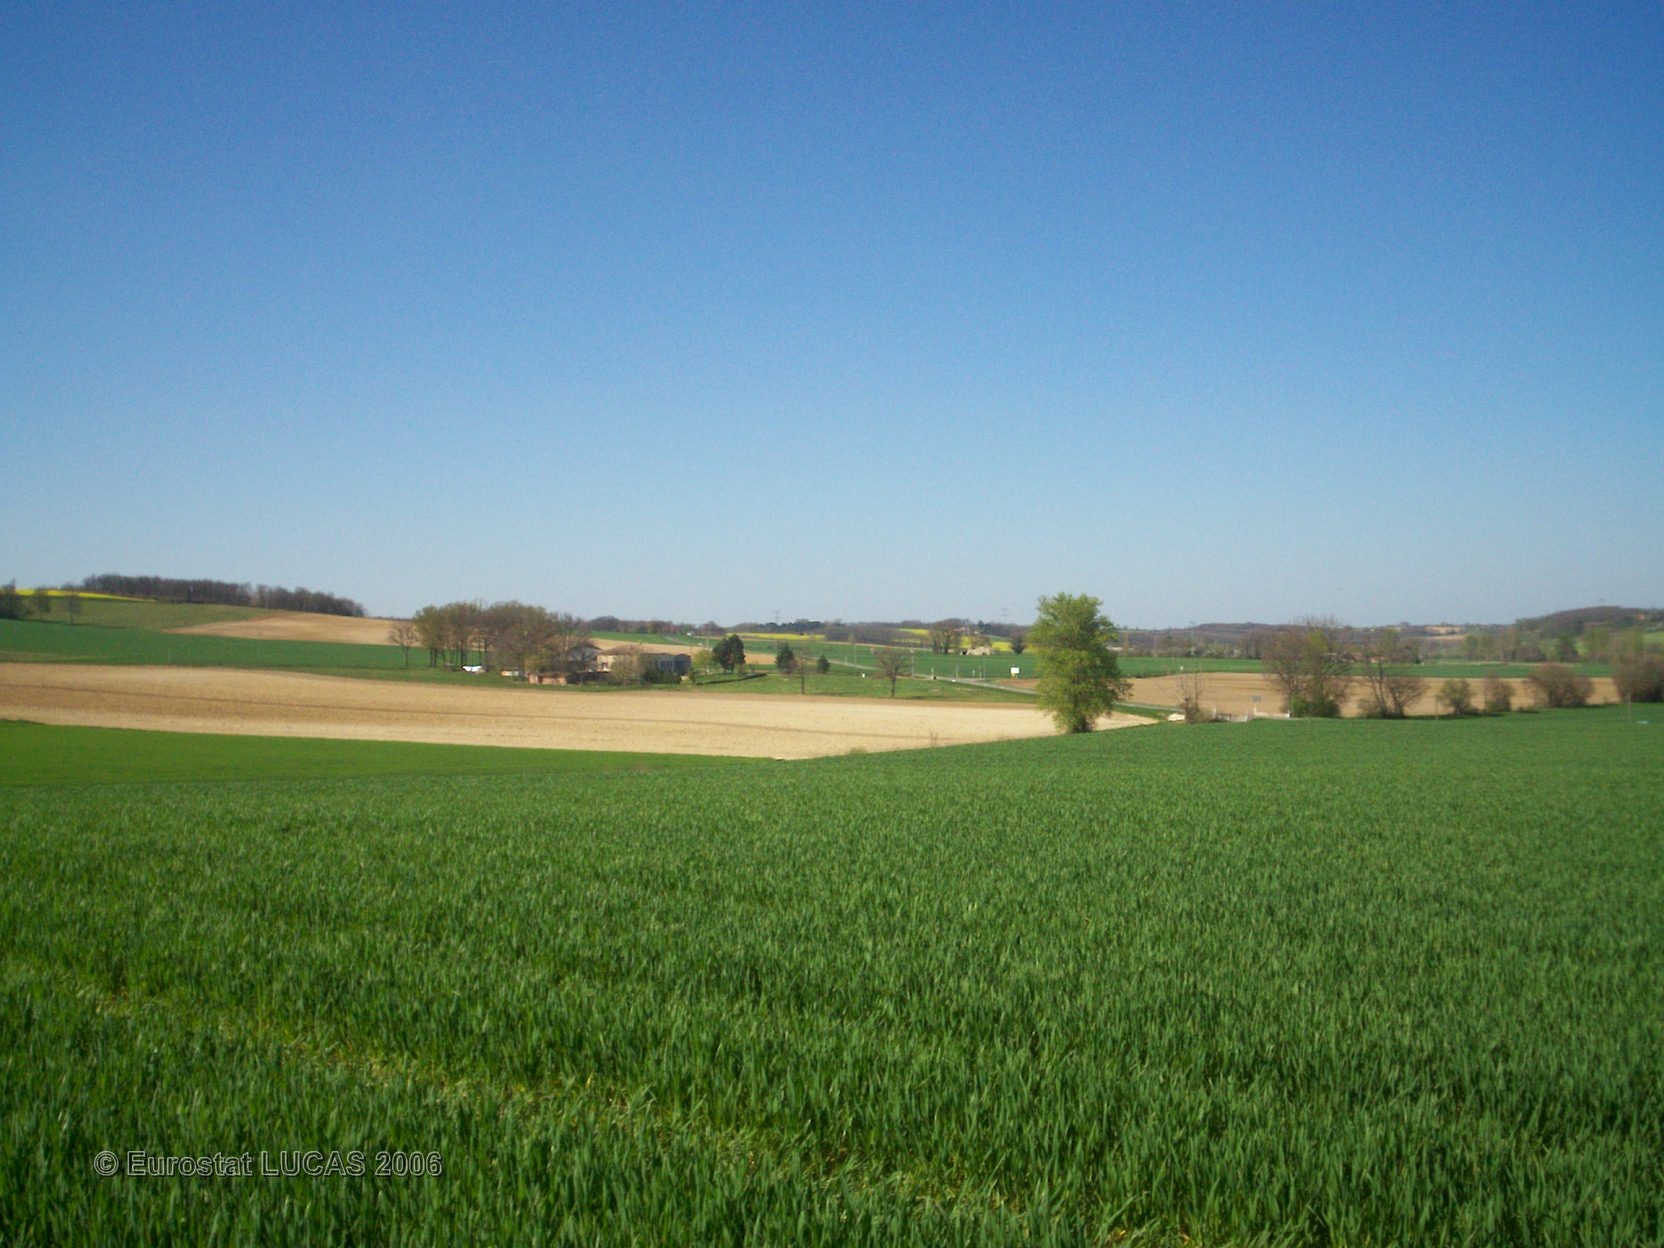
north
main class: Cropland
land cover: Common wheat
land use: Agriculture (excluding fallow land and kitchen gardens)
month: April
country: FR
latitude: 43.9870
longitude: 0.9084
